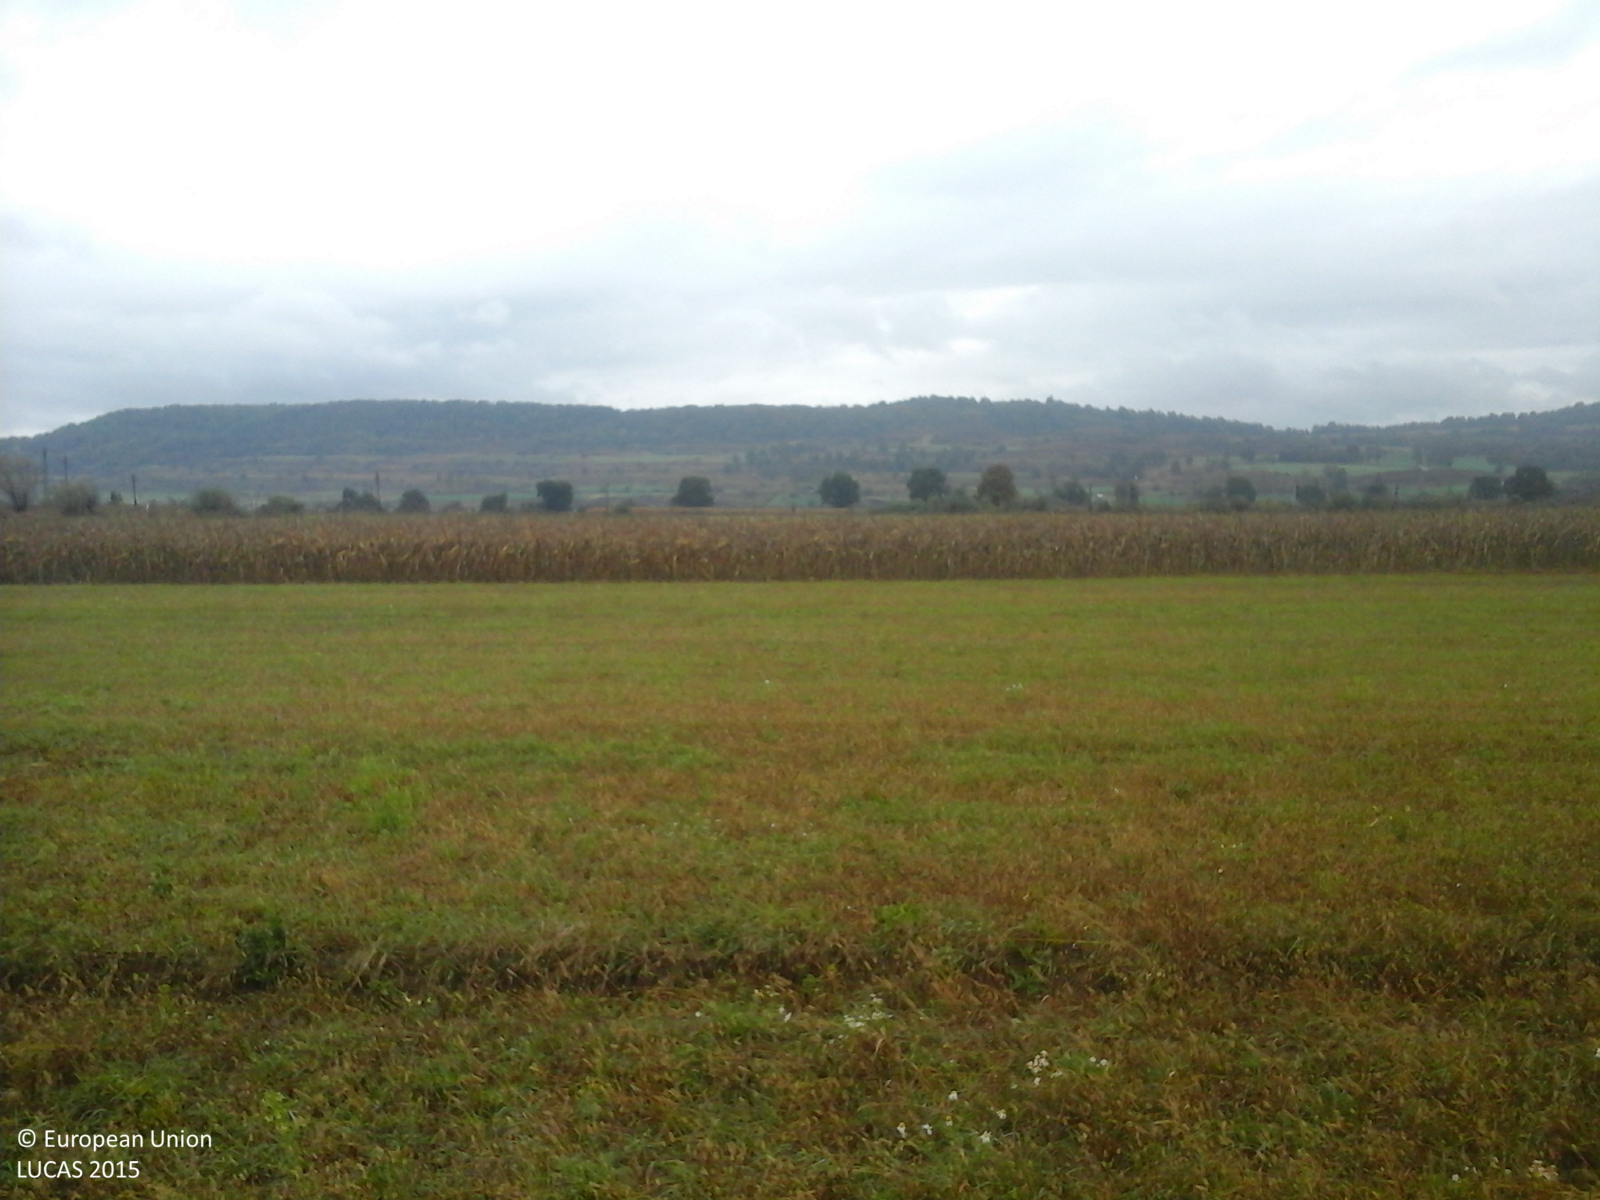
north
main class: Grassland
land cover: Grassland without tree/shrub cover
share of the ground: > 75 %
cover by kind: herbaceous plants 100 %
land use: Agriculture (excluding fallow land and kitchen gardens)
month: October
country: RO
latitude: 45.7811
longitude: 24.6047
